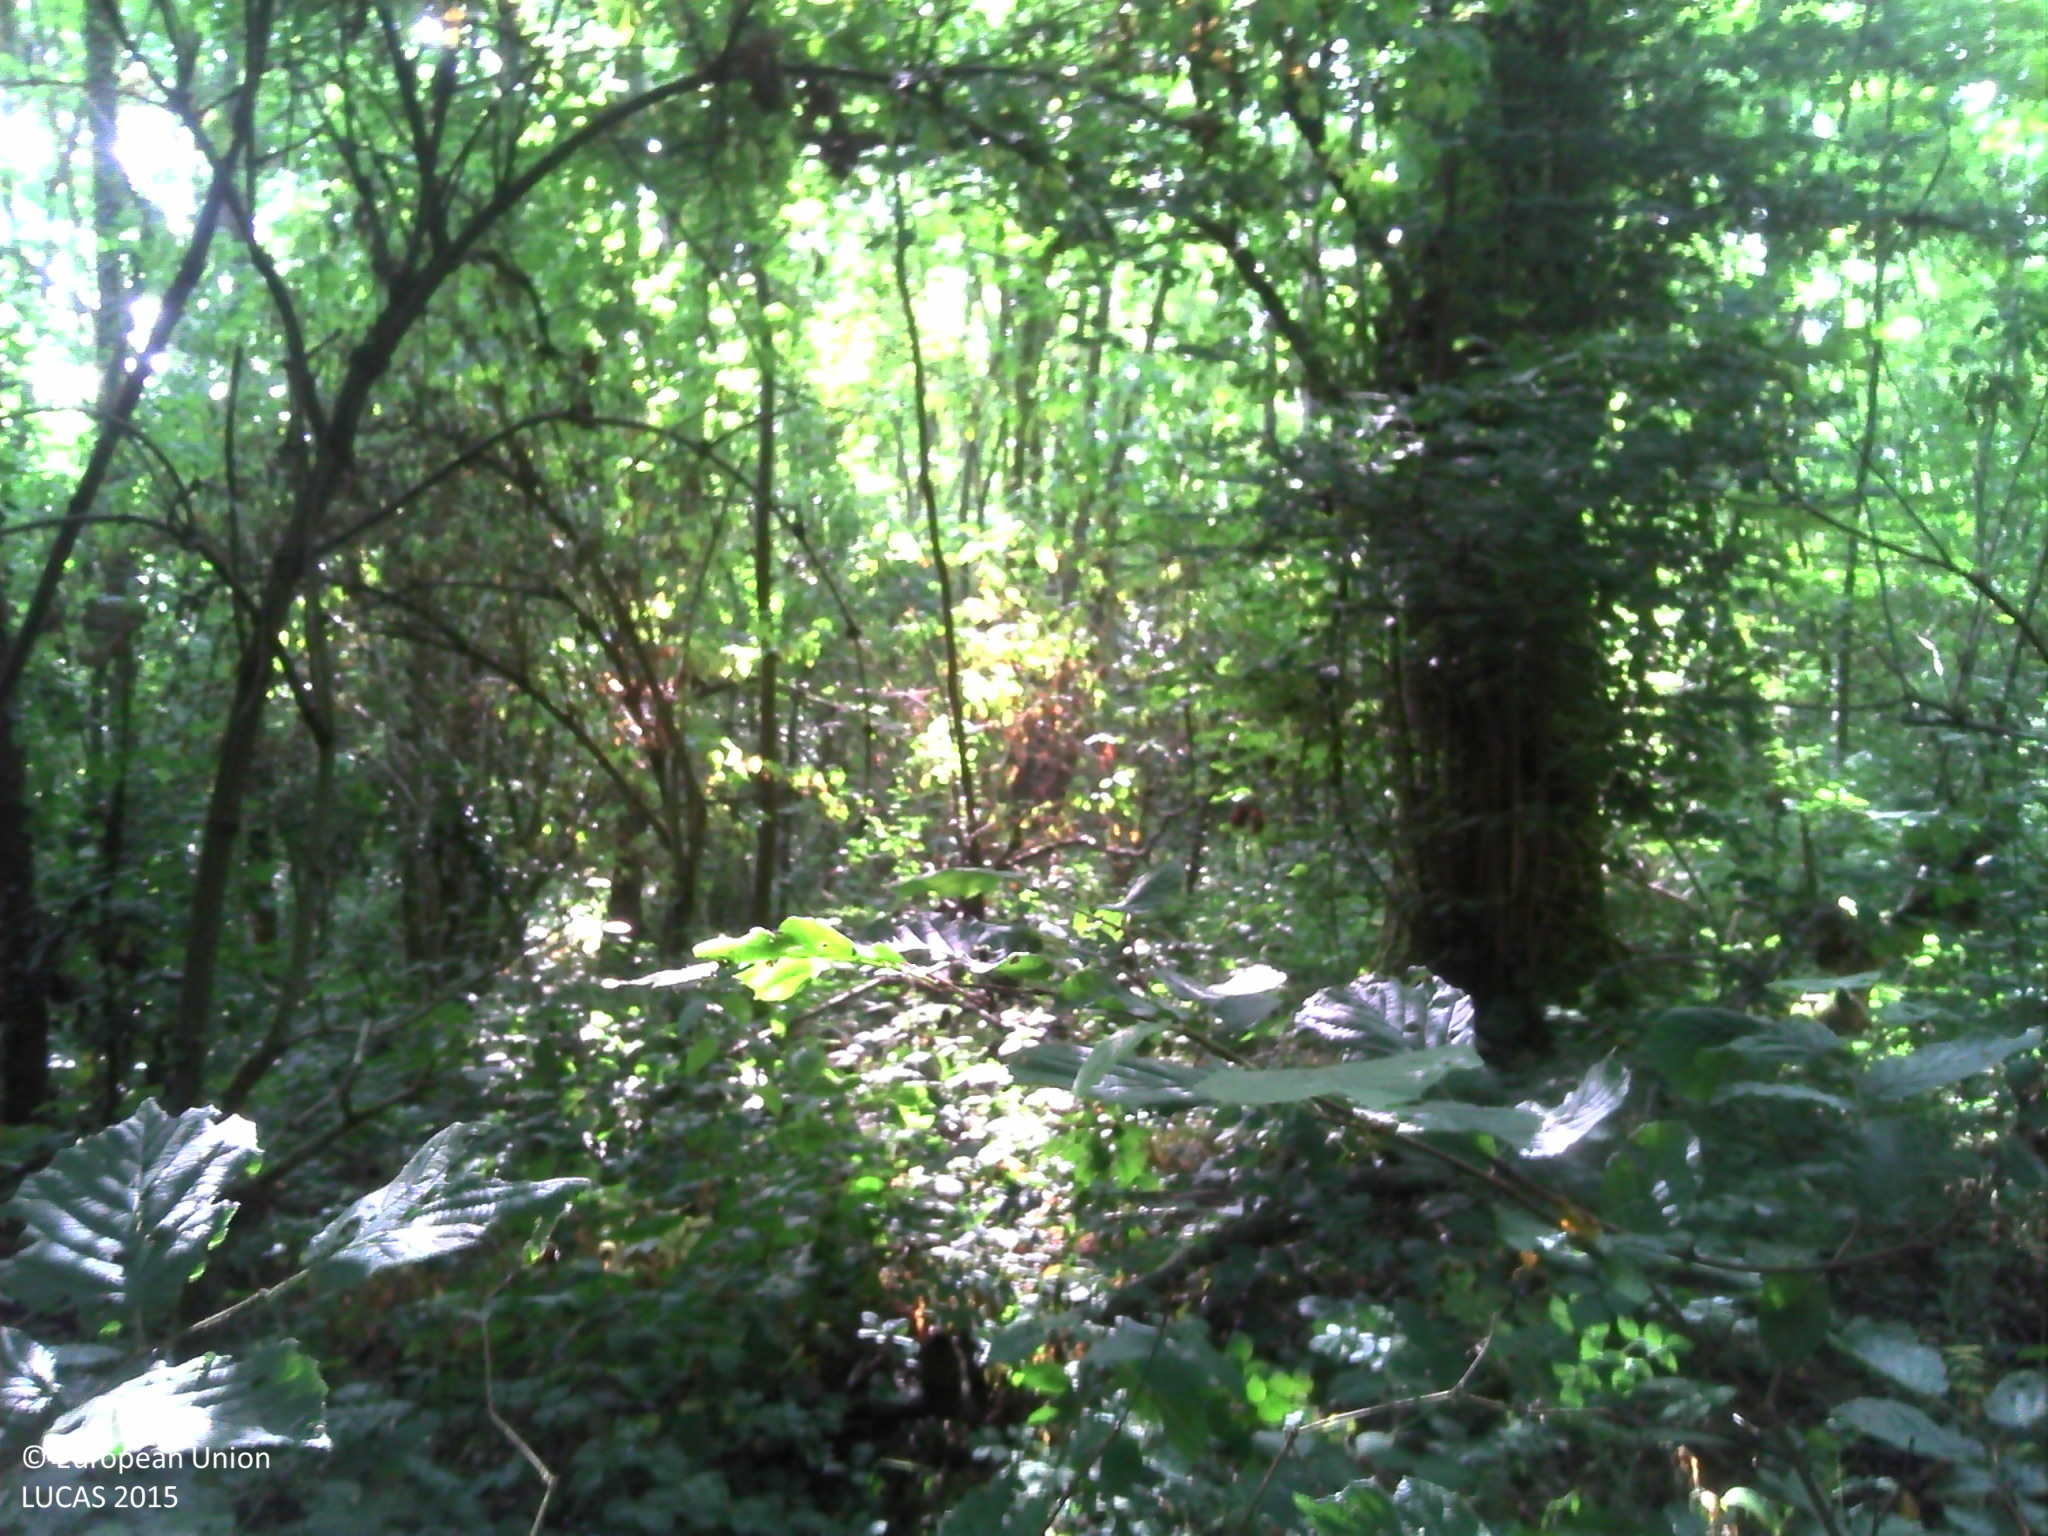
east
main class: Woodland
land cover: Broadleaved woodland
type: mesophytic deciduous forest
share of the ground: > 75 %
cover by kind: broadleaved forest trees 80 %, herbaceous plants 15 %, lichens and mosses 5 %
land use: Forestry
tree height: > 5 m
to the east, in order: Broadleaved woodland; Grass margins; Tracks; Grass margins; Rape and turnip rape
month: July
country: FR
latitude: 48.2413
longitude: 3.3825
